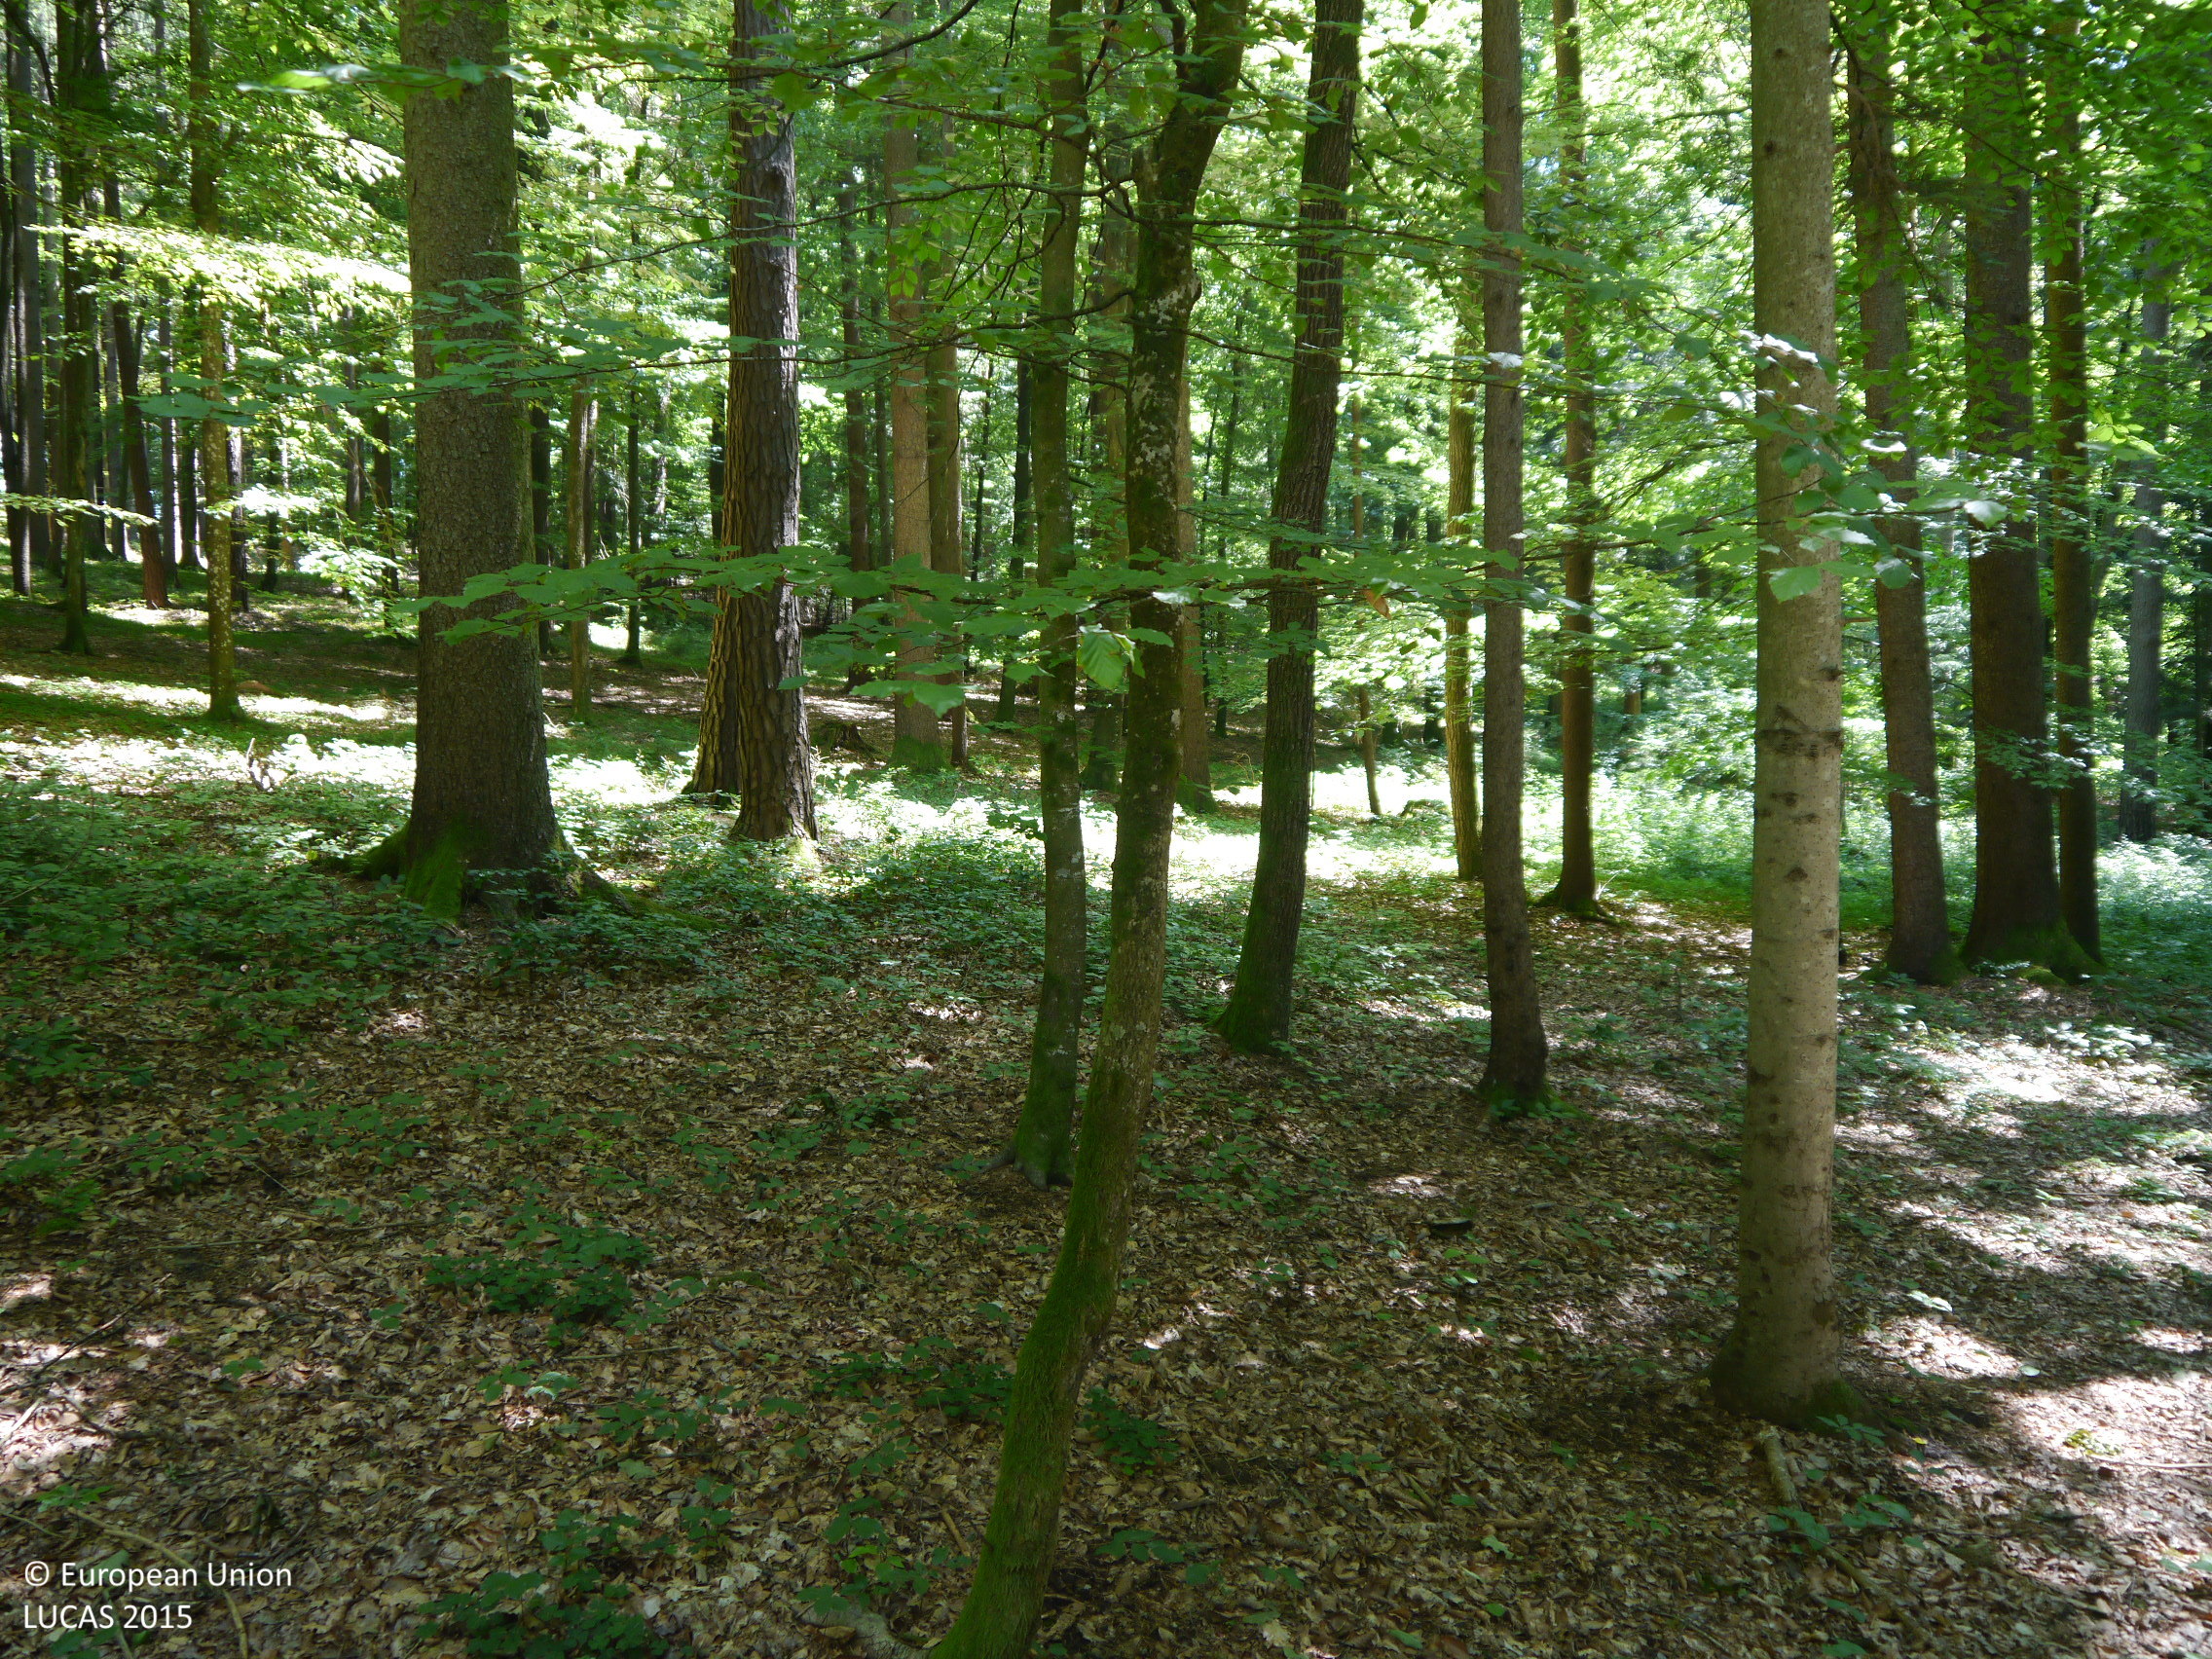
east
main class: Woodland
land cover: Other mixed woodland
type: mountainous beech forest
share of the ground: > 75 %
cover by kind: broadleaved forest trees 70 %, coniferous forest trees 30 %
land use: Forestry
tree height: > 5 m
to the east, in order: Other mixed woodland; Spruce dominated mixed woodland; Other mixed woodland; Paved roads, cycling and walking lanes; Spruce dominated mixed woodland; Broadleaved woodland
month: June
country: AT
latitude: 46.9055
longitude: 15.6581
